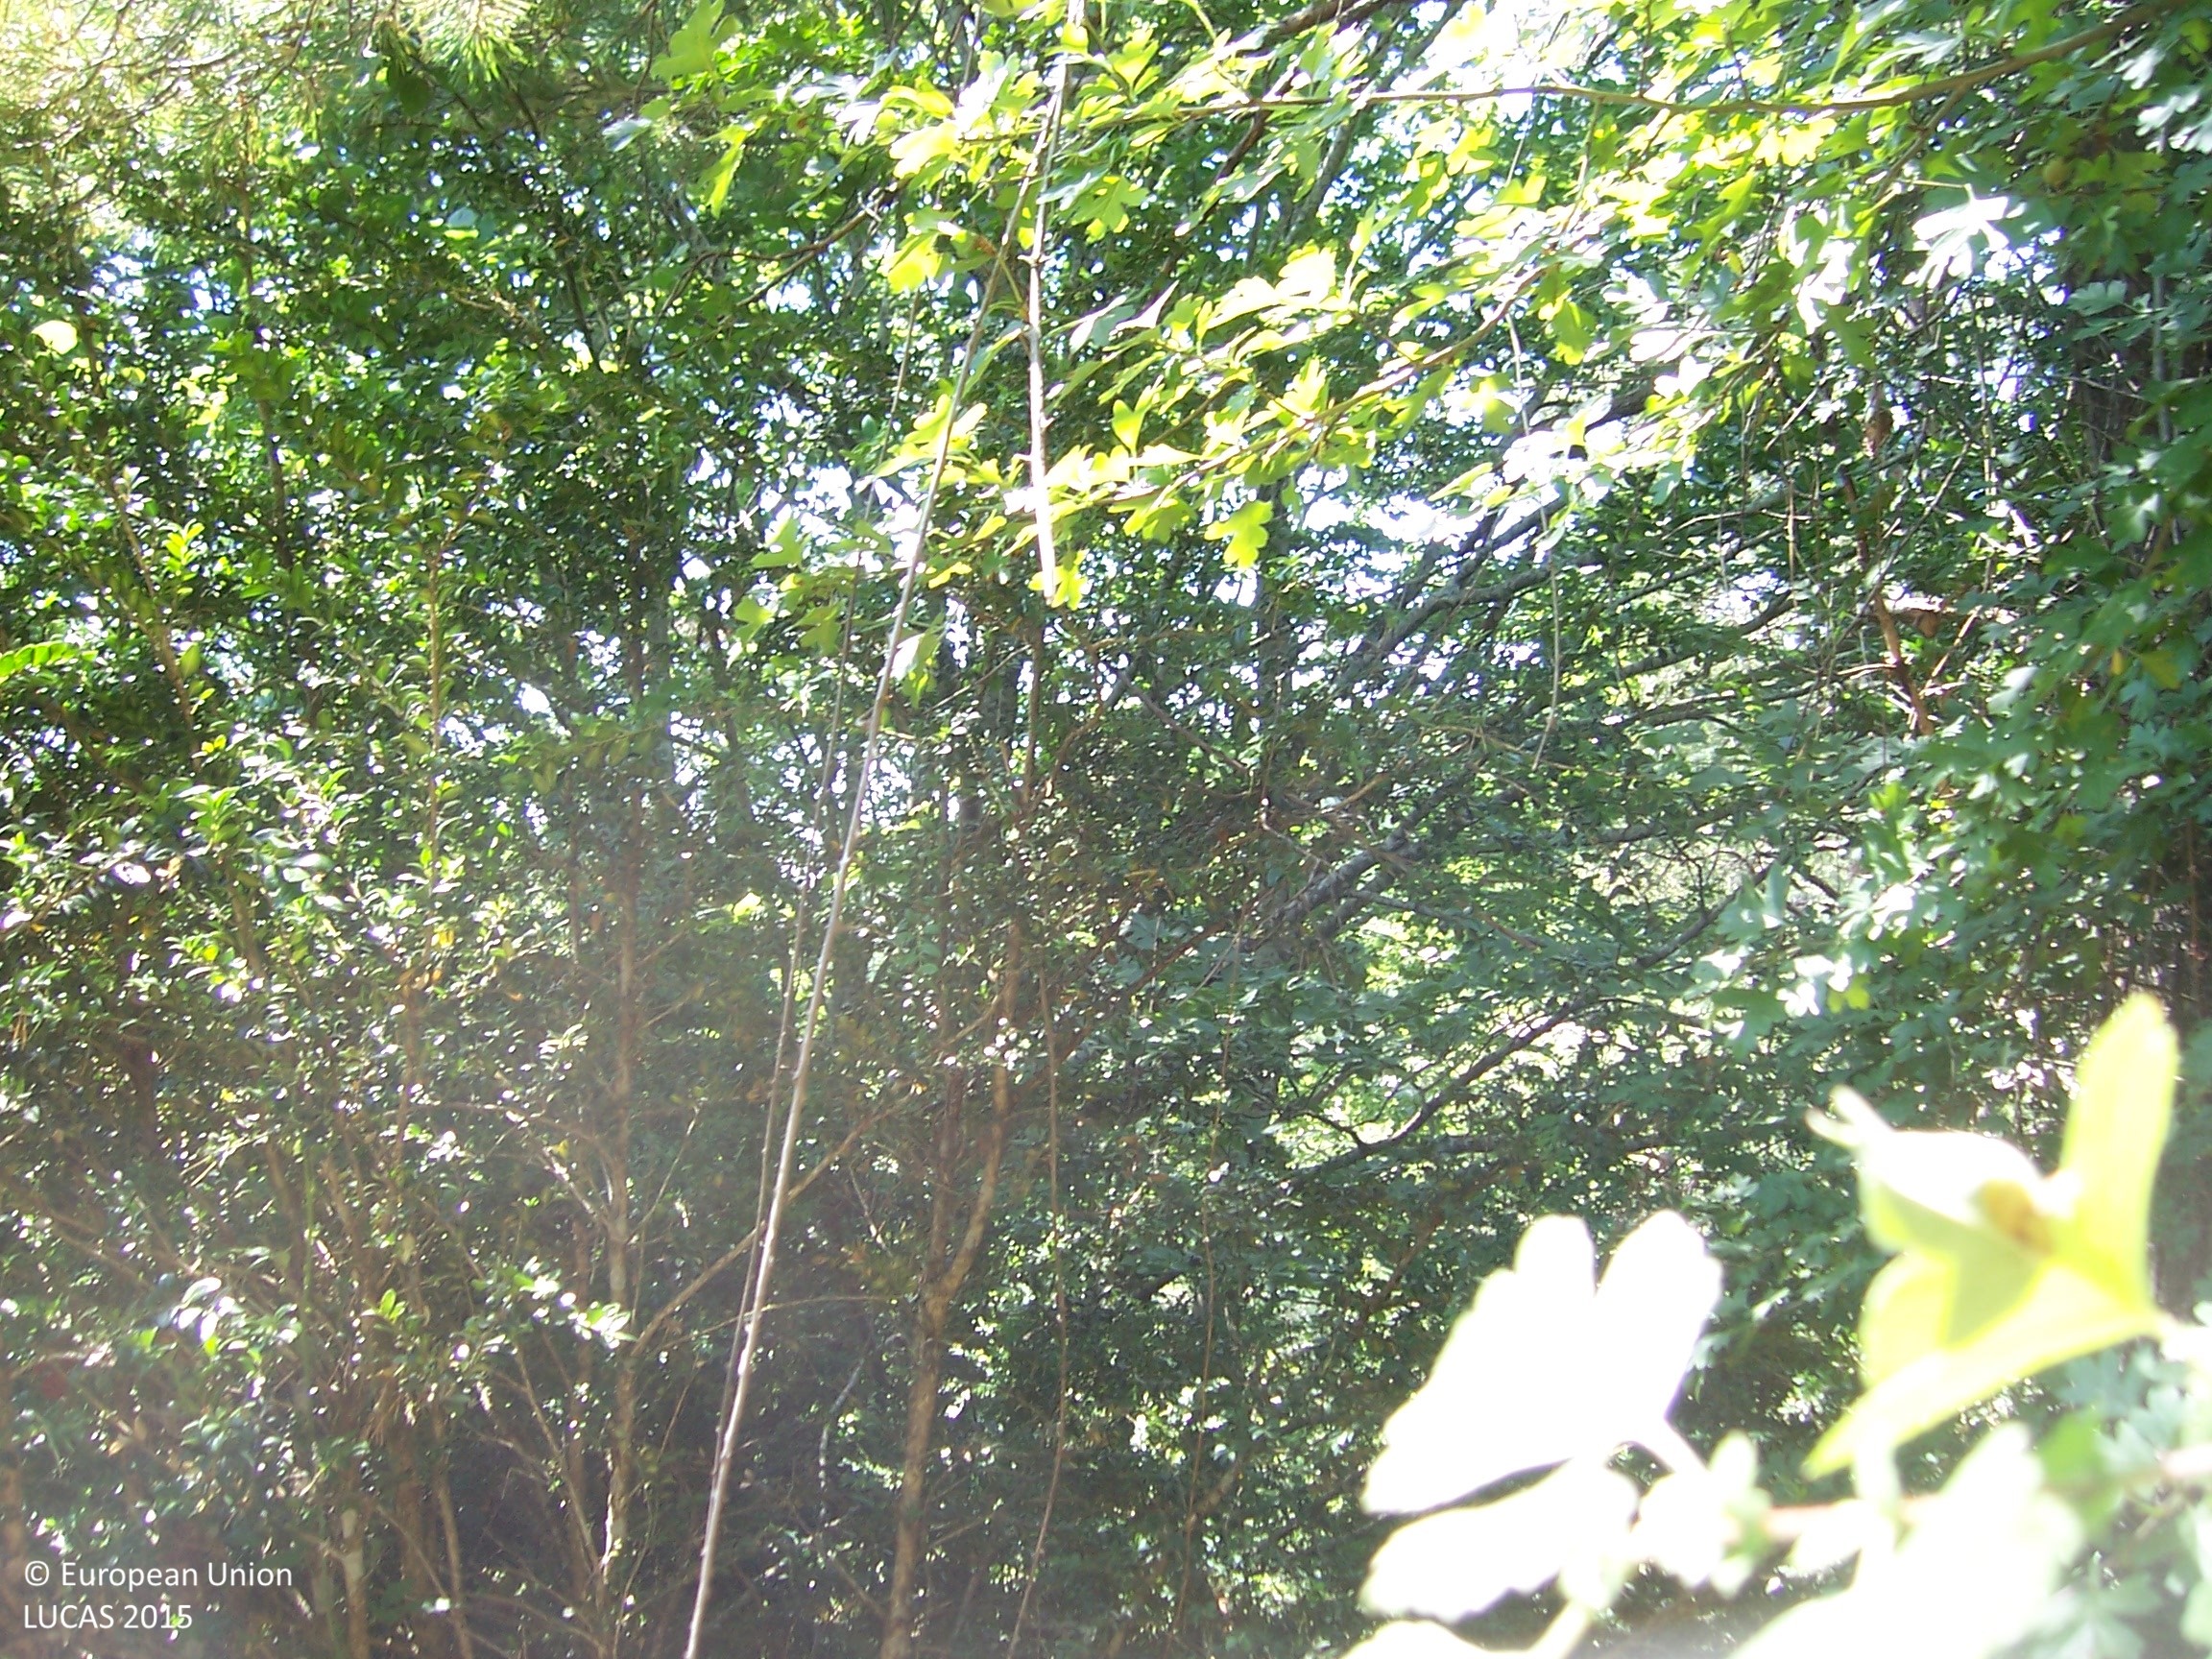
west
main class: Woodland
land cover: Broadleaved woodland
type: beech forest
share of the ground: > 75 %
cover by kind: broadleaved forest trees 75 %, coniferous forest trees 20 %, shrubs 5 %
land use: Forestry
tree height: > 5 m
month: July
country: ES
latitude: 42.8620
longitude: -1.2592
